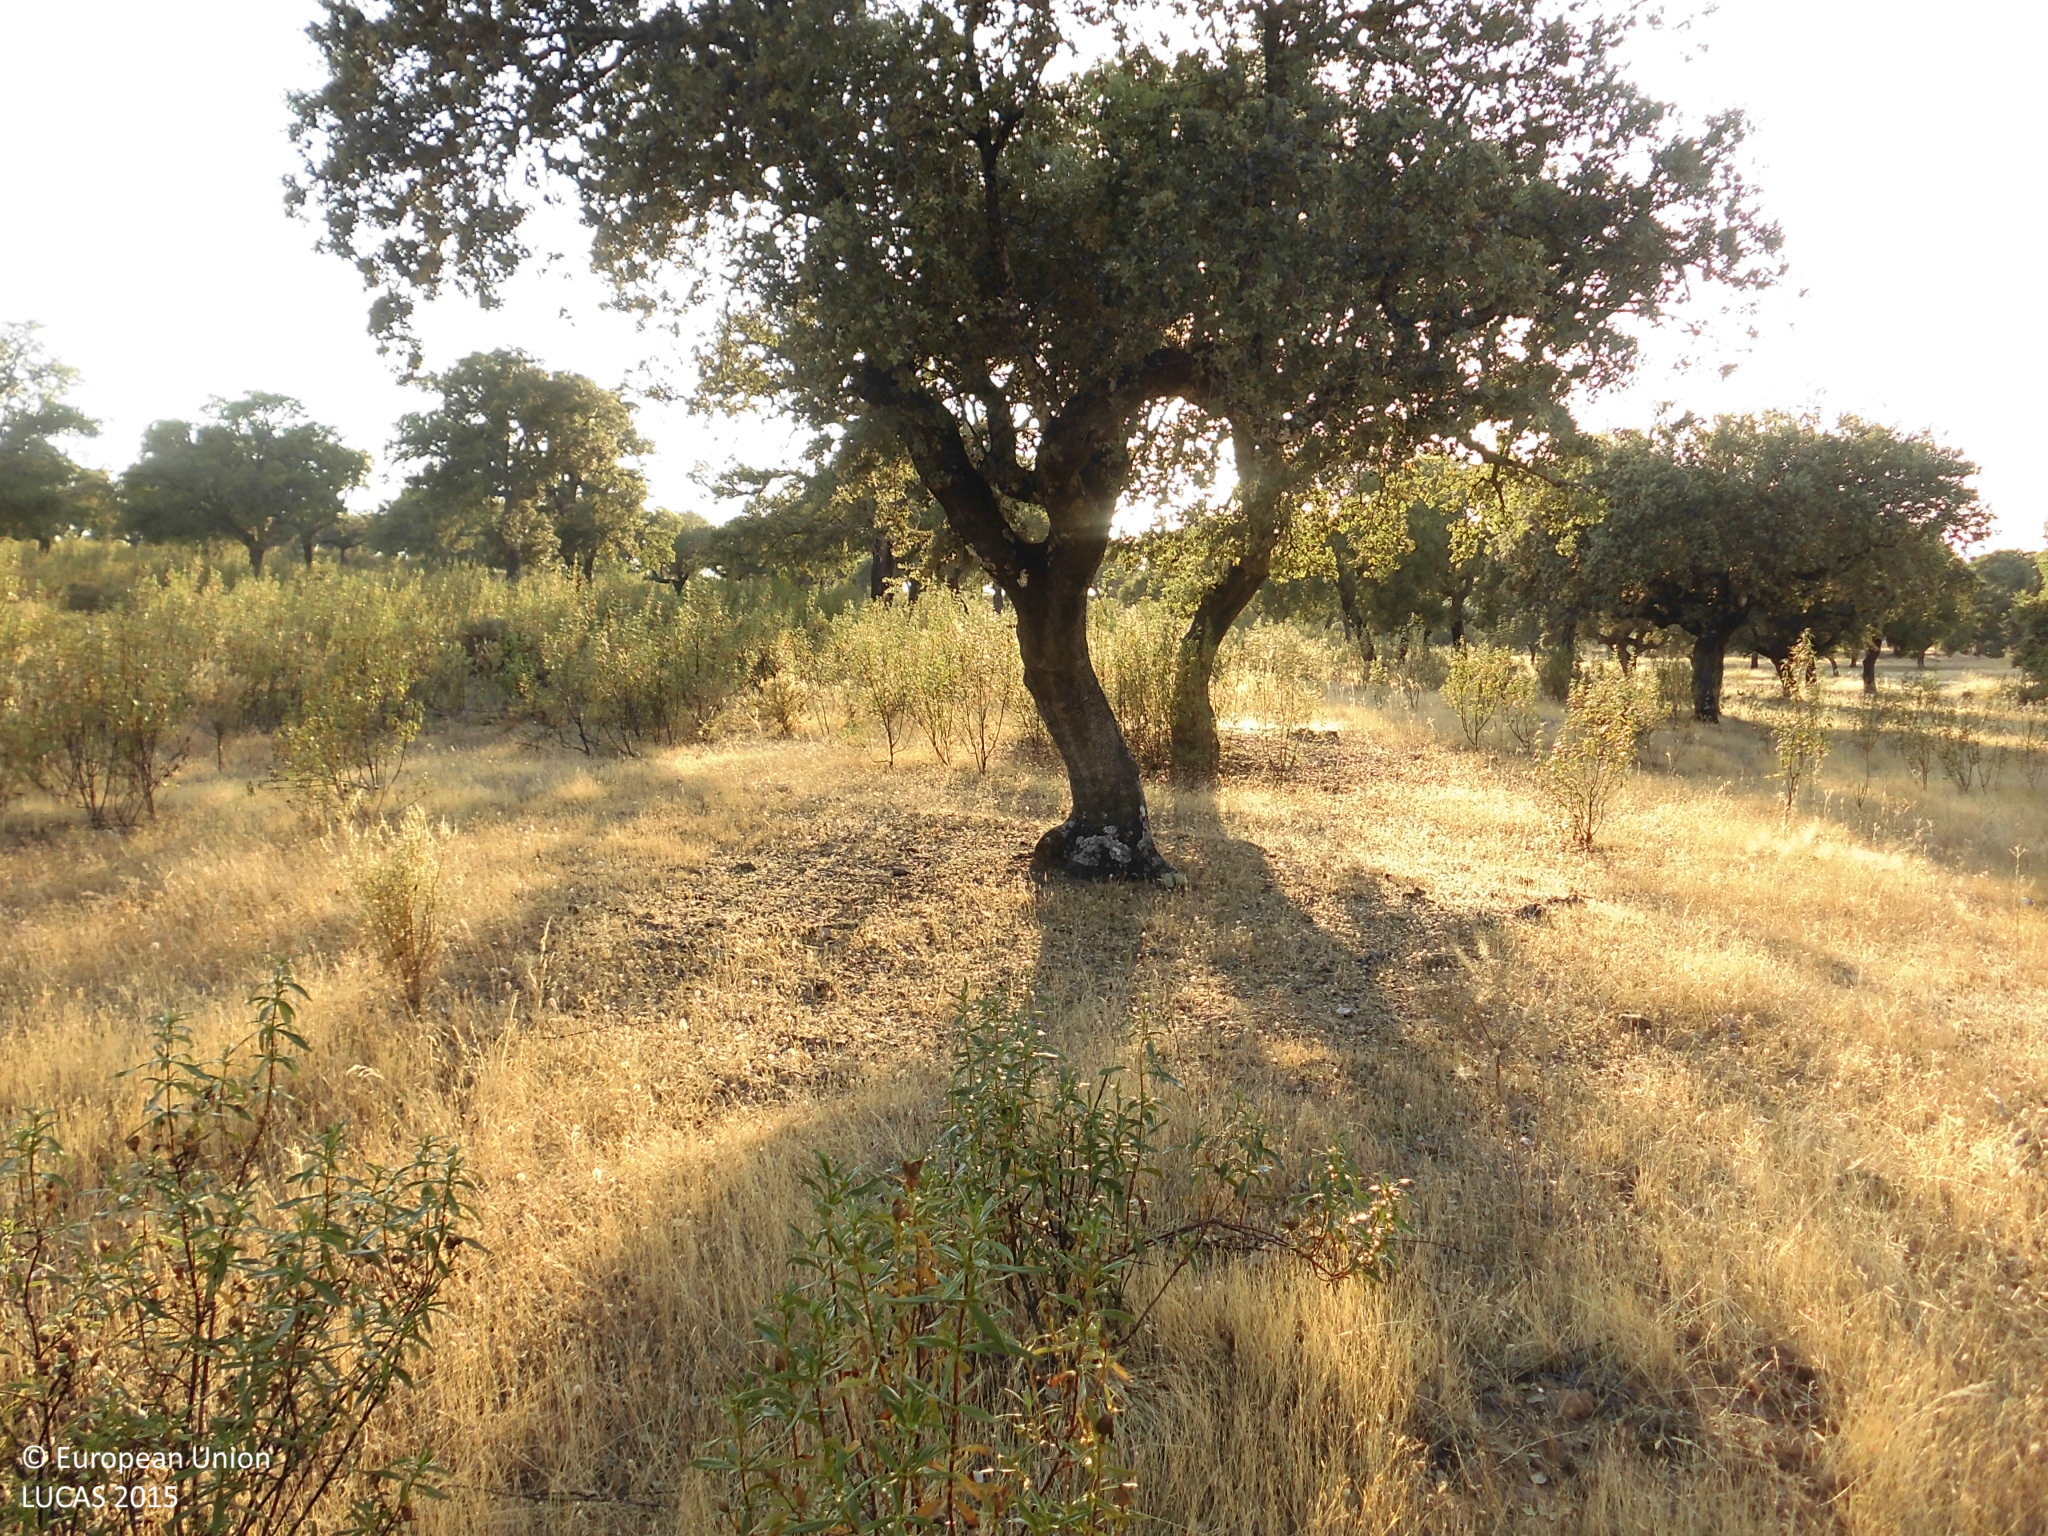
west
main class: Woodland
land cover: Broadleaved woodland
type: broadleaved evergreen forest
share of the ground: 10 - 25 %
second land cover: Grassland without tree/shrub cover
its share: > 75 %
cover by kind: herbaceous plants 60 %, broadleaved forest trees 30 %, shrubs 10 %
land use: Forestry
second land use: Agriculture (excluding fallow land and kitchen gardens)
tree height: > 5 m
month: June
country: ES
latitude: 39.9213
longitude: -5.9913
